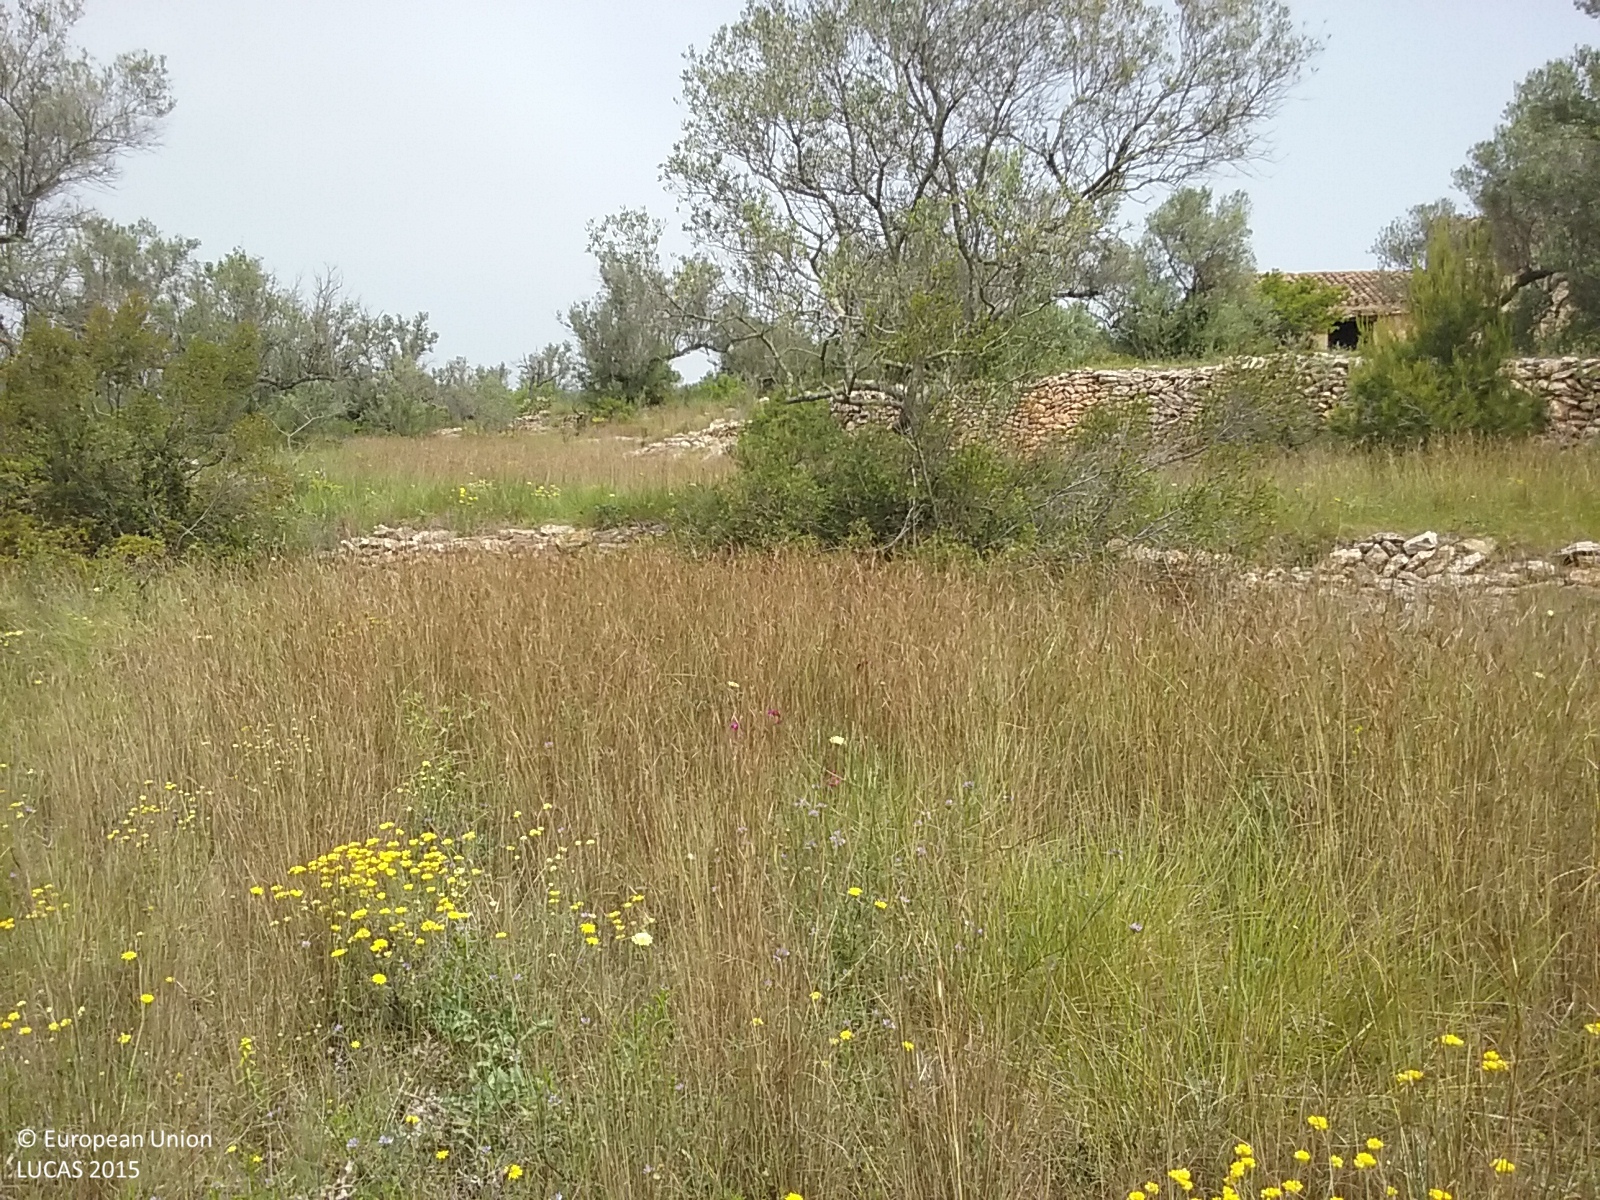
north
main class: Cropland
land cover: Olive groves
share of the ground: 25 - 50 %
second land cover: Grassland without tree/shrub cover
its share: > 75 %
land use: Abandoned areas
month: May
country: ES
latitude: 40.7974
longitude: 0.5954
